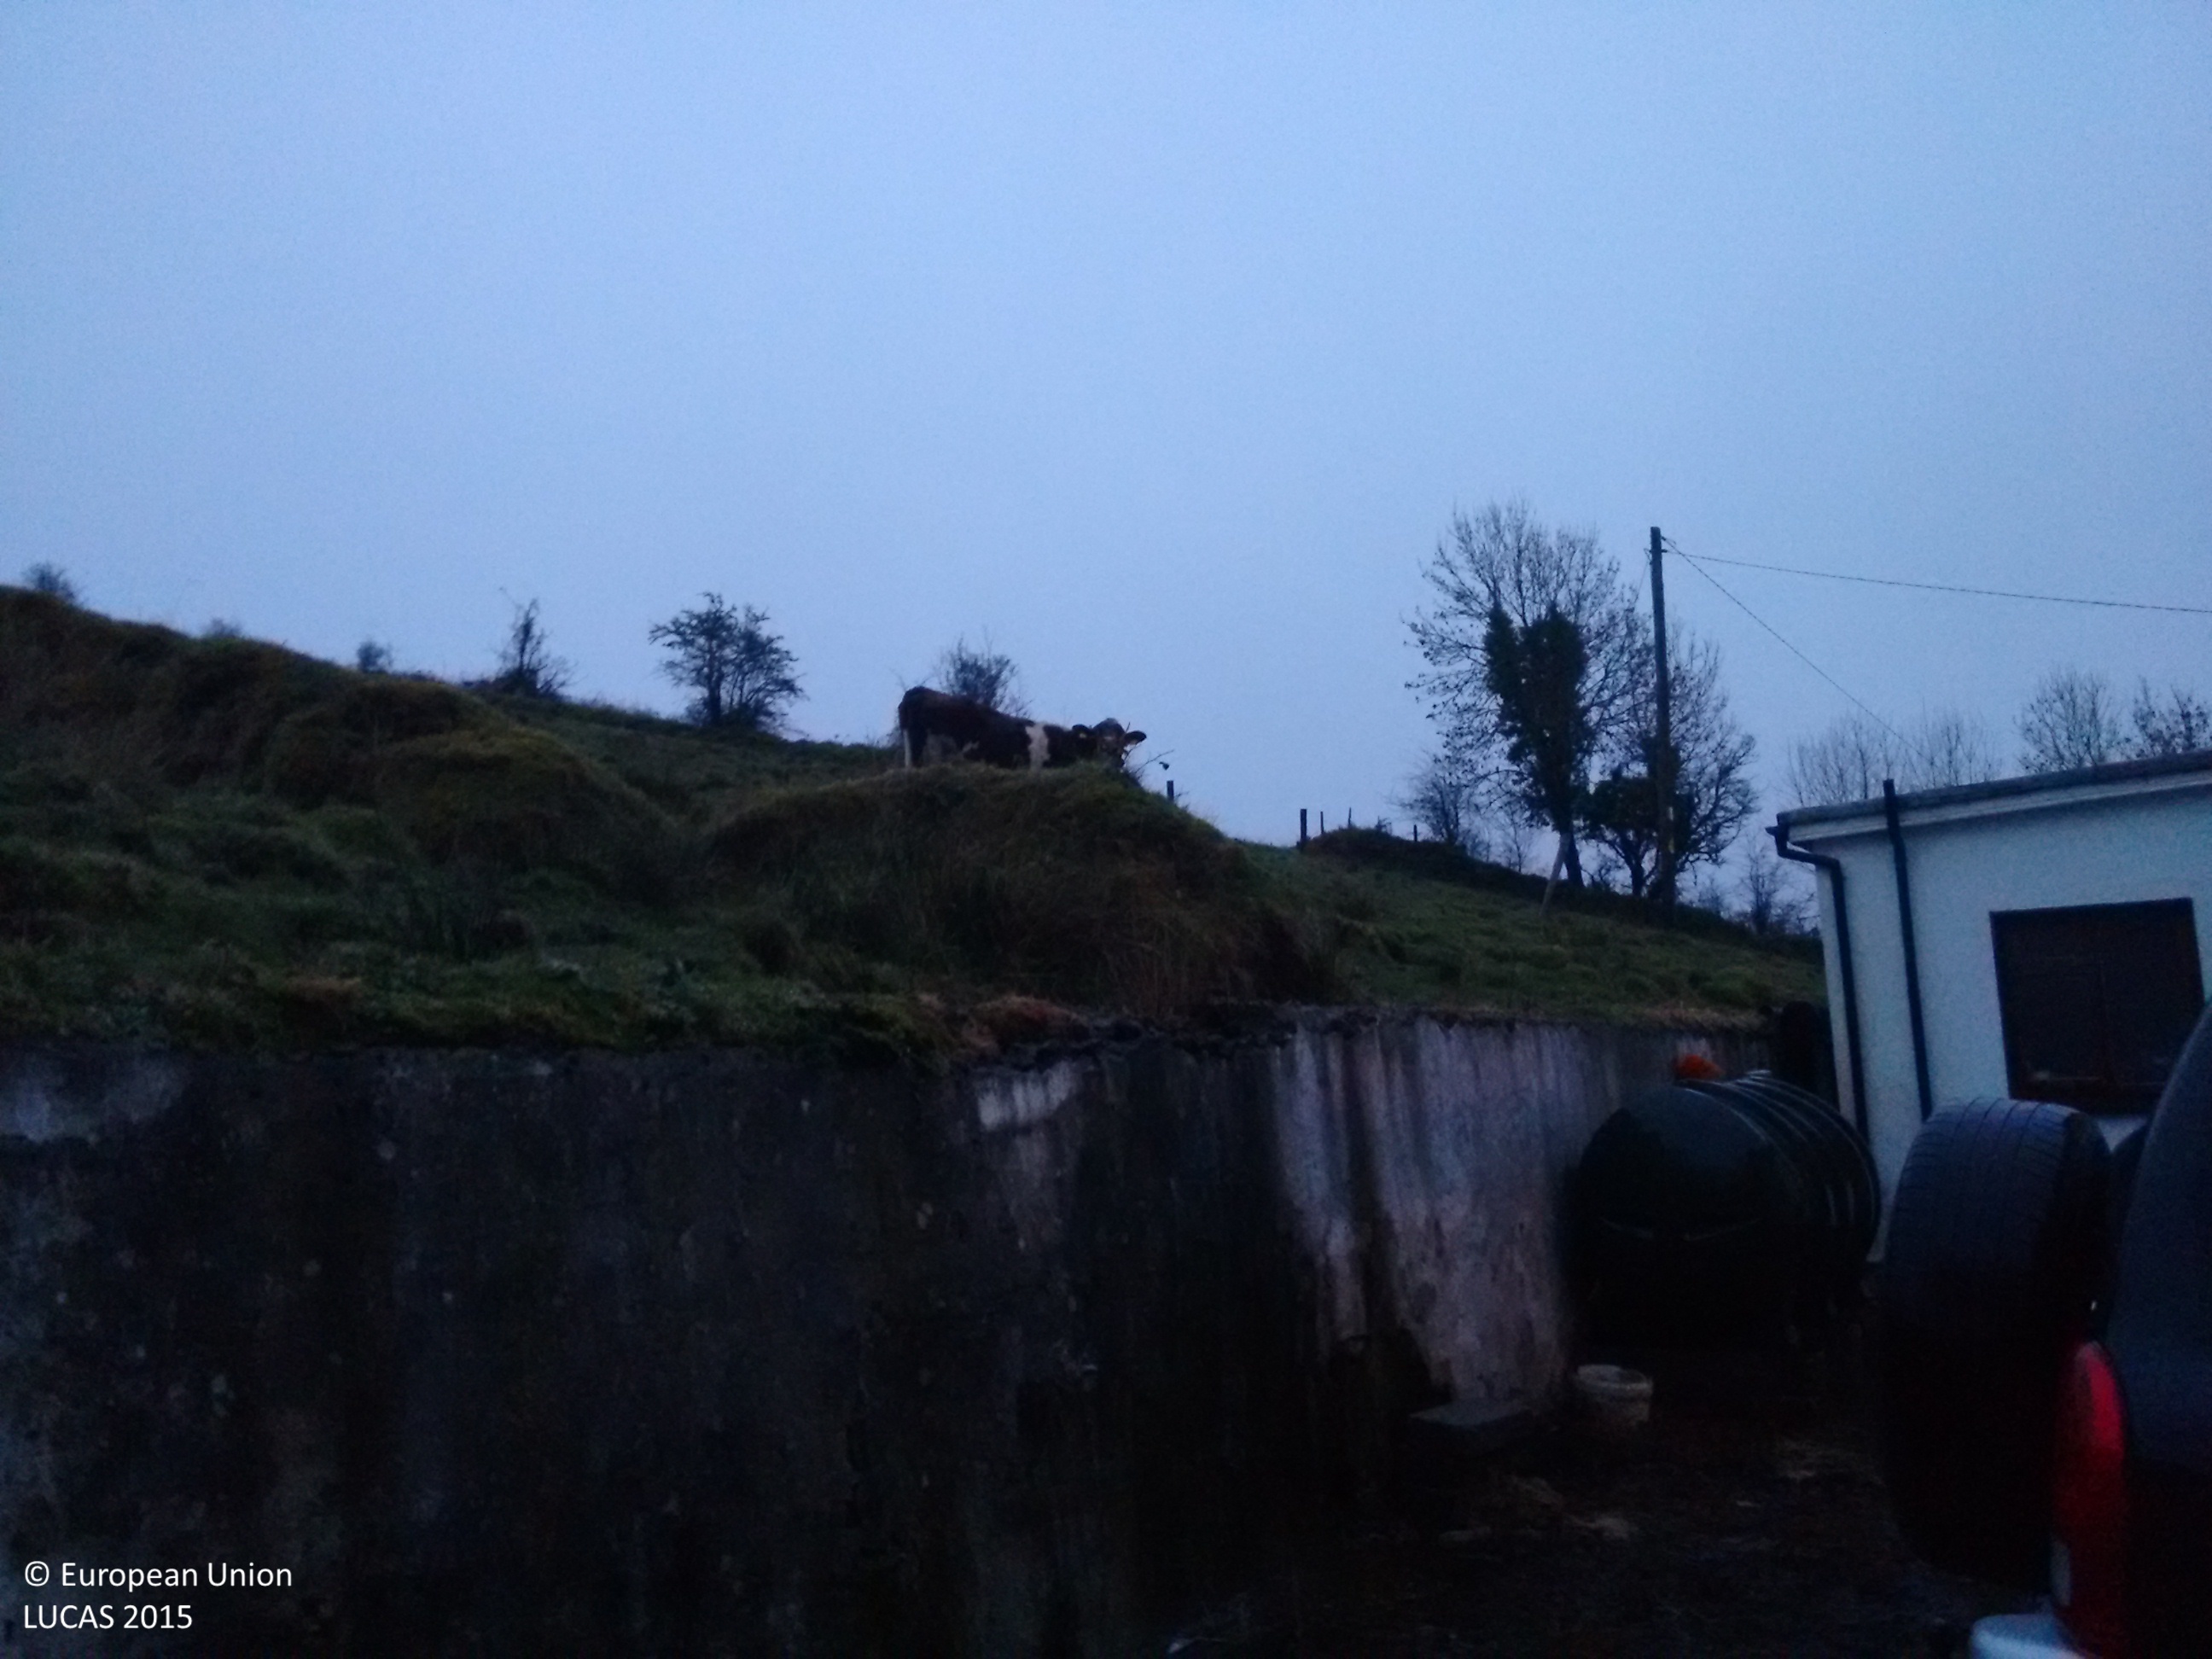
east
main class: Grassland
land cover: Grassland without tree/shrub cover
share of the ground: > 75 %
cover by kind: herbaceous plants 100 %
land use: Agriculture (excluding fallow land and kitchen gardens)
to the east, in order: Grassland without tree/shrub cover; Single bushes/trees; Grassland without tree/shrub cover; Abandoned hedges; Grassland without tree/shrub cover; Abandoned hedges; Grassland without tree/shrub cover
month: November
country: IE
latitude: 54.1295
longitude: -8.3197
